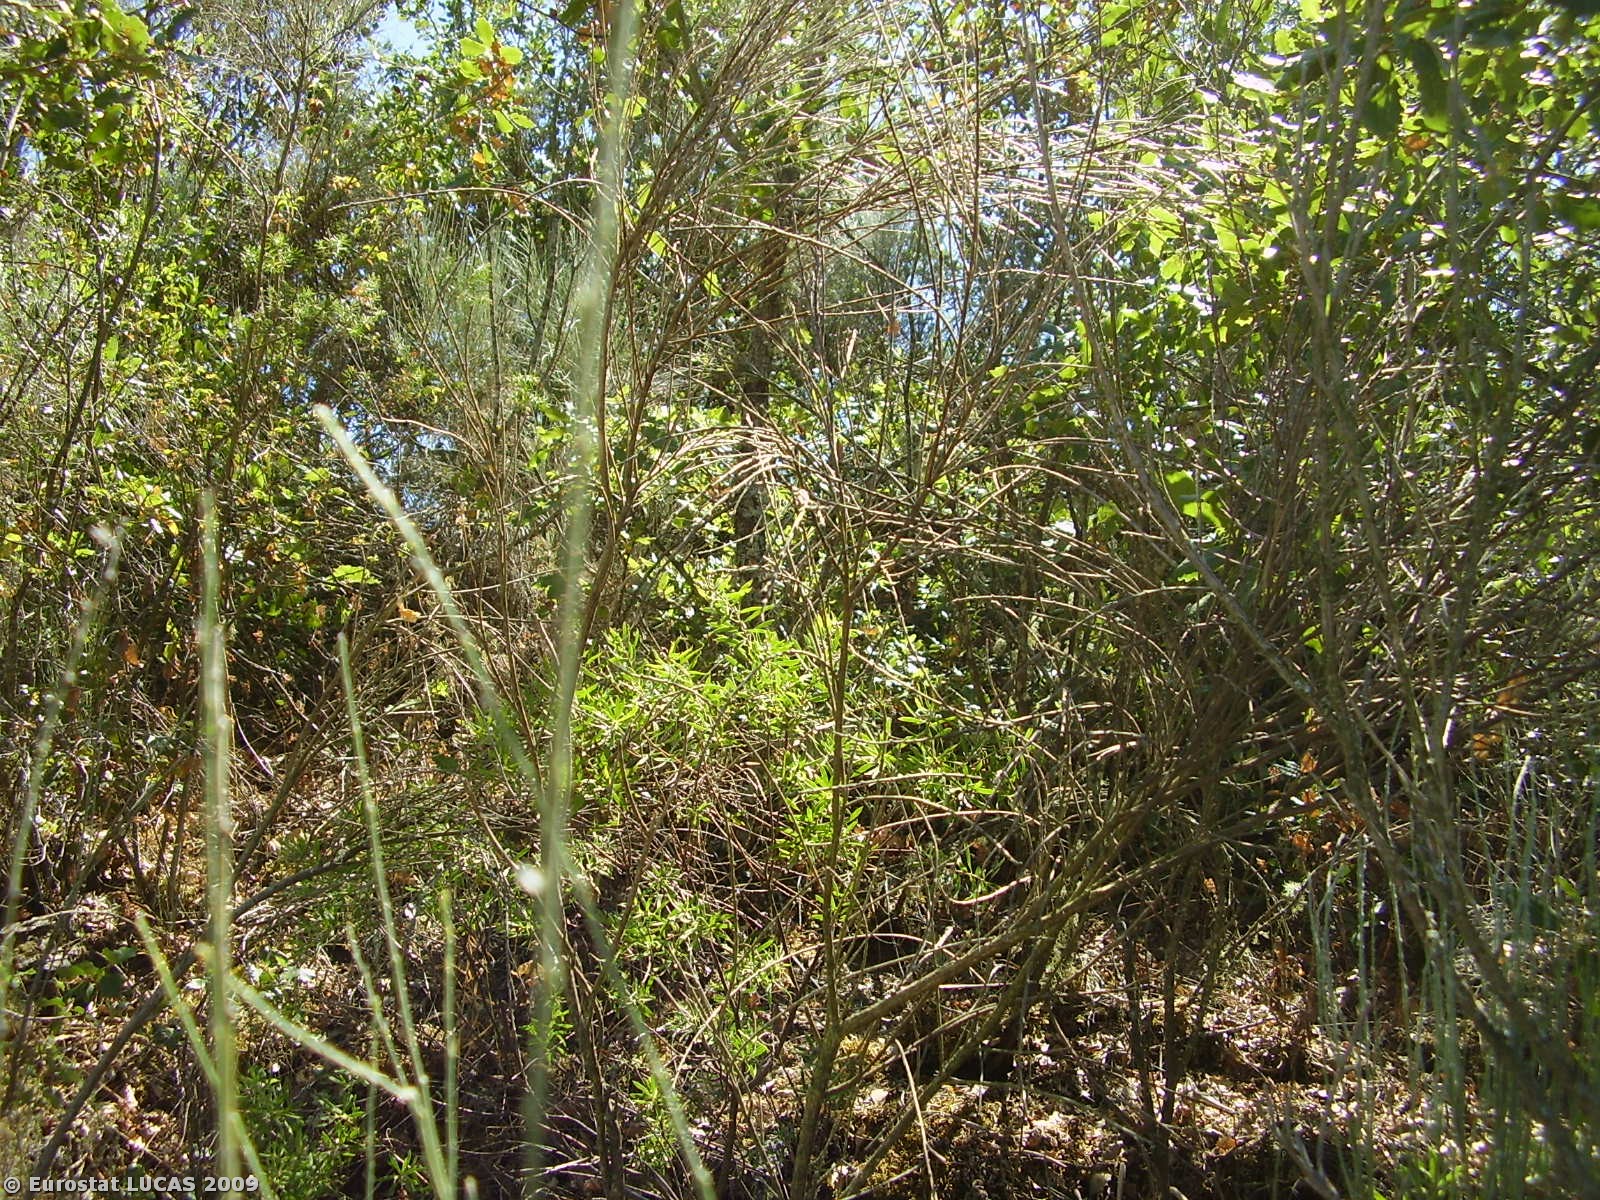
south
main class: Cropland
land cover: Olive groves
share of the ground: 50 - 75 %
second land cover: Bare land
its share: > 75 %
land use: Agriculture (excluding fallow land and kitchen gardens)
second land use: Fallow land
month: August
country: PT
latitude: 41.1985
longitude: -6.7137
